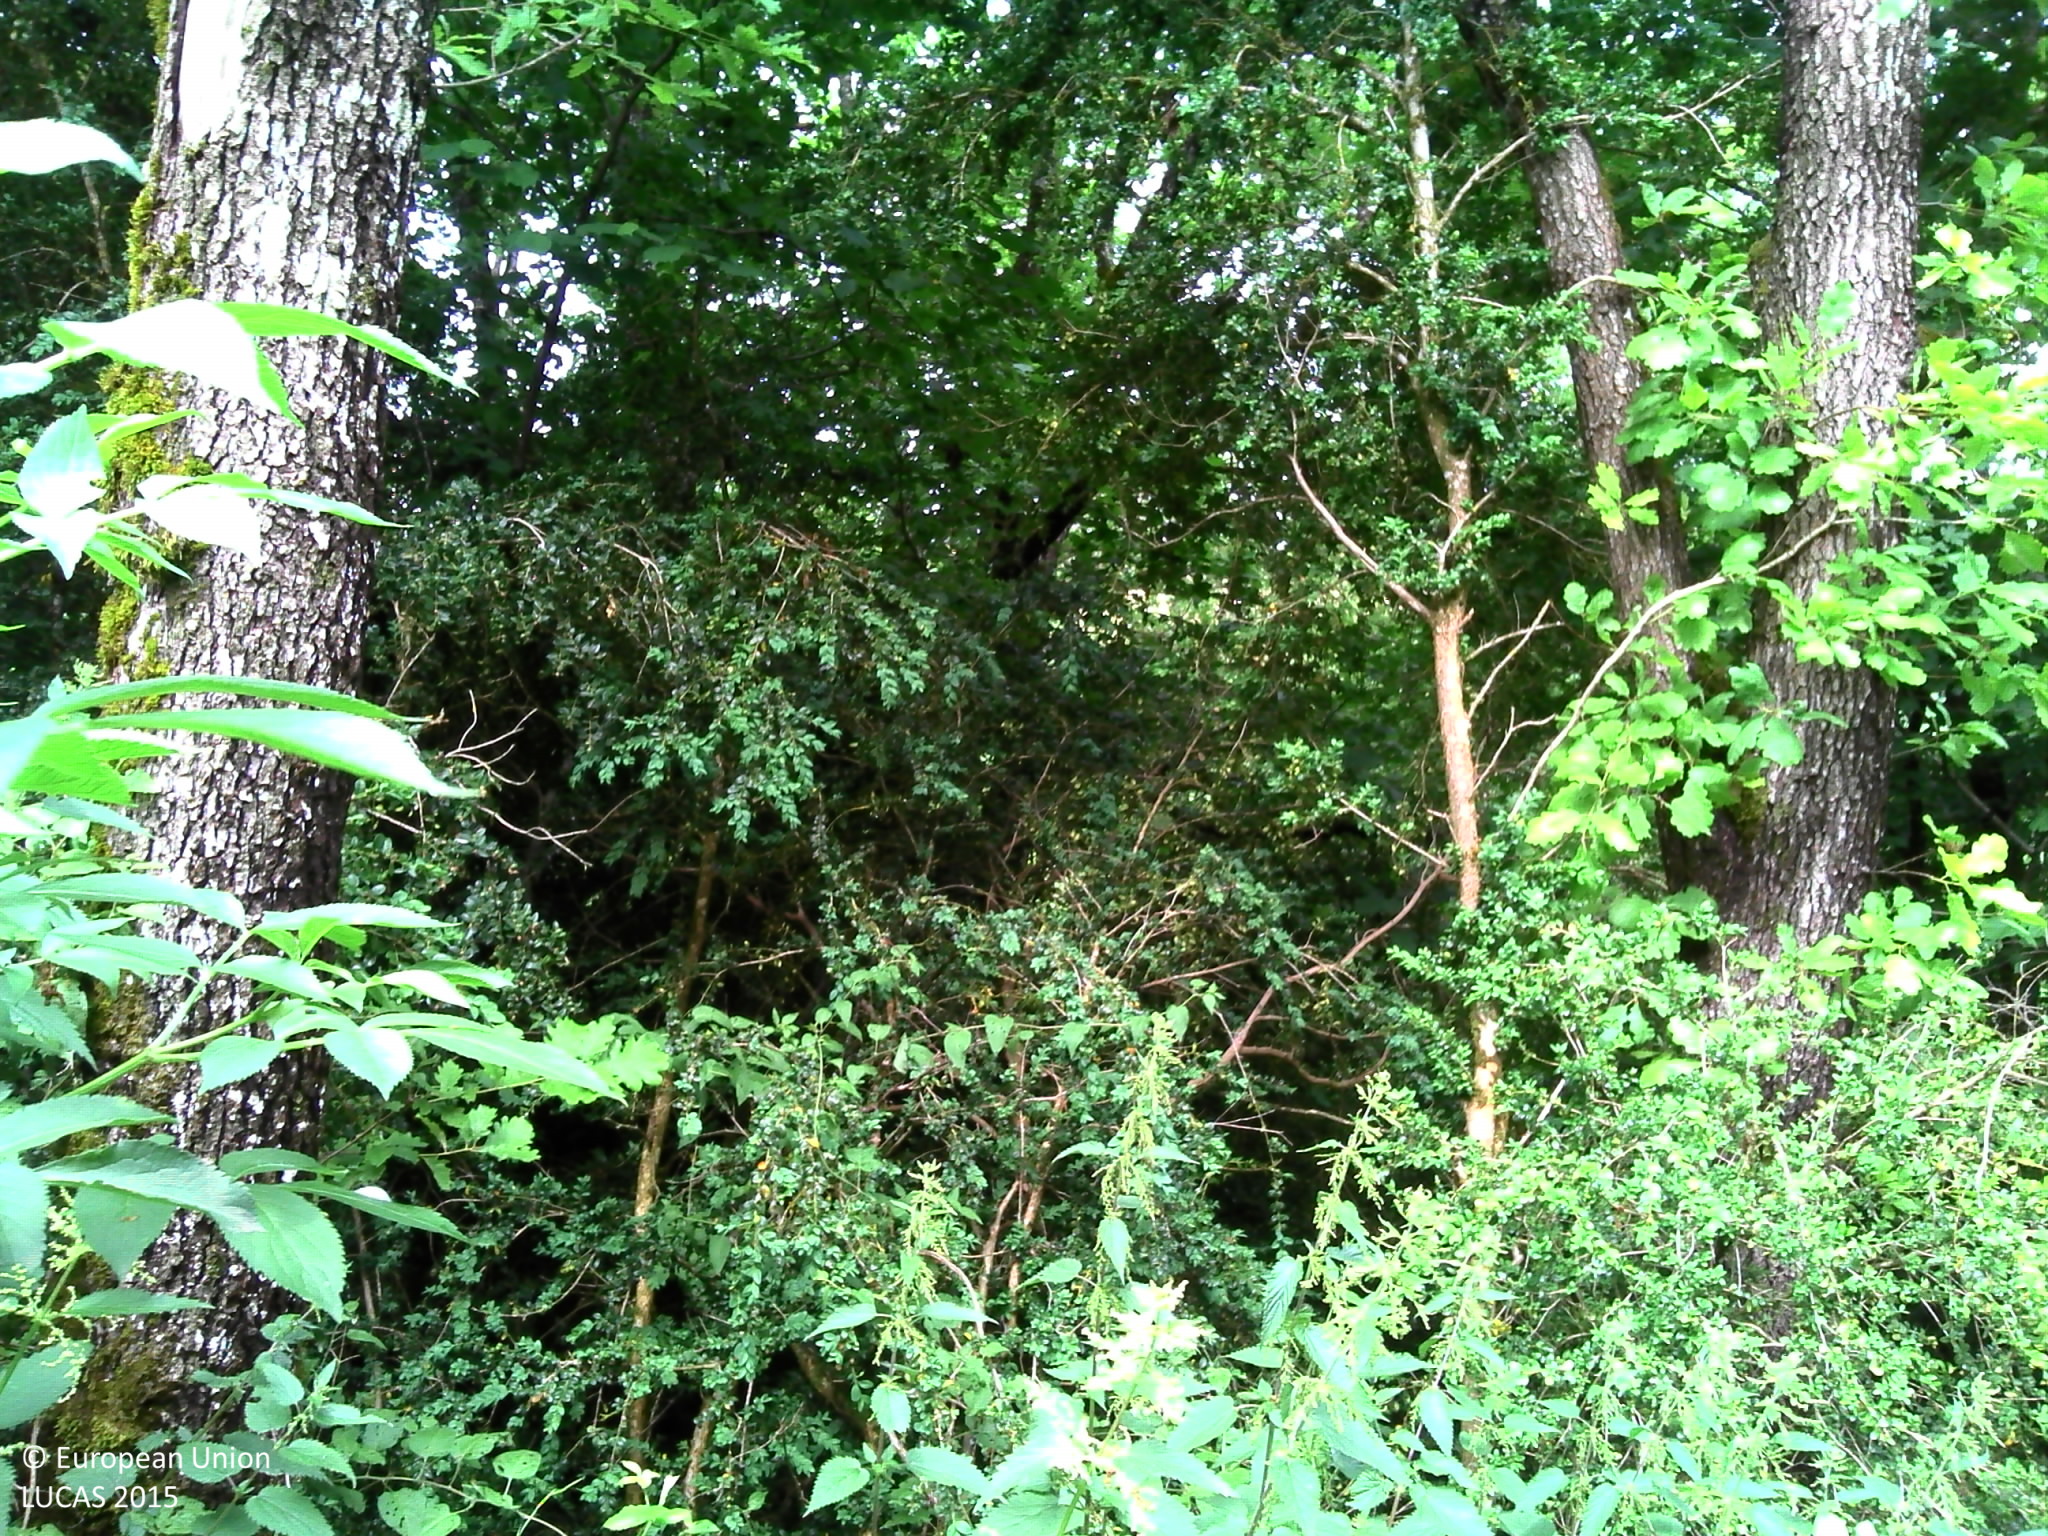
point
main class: Woodland
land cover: Broadleaved woodland
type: acidophilous oak and oak-birch forest
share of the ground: > 75 %
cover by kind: broadleaved forest trees 90 %, lichens and mosses 10 %
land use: Semi-natural and natural areas not in use
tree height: > 5 m
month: June
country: FR
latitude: 44.2820
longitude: 3.0758
